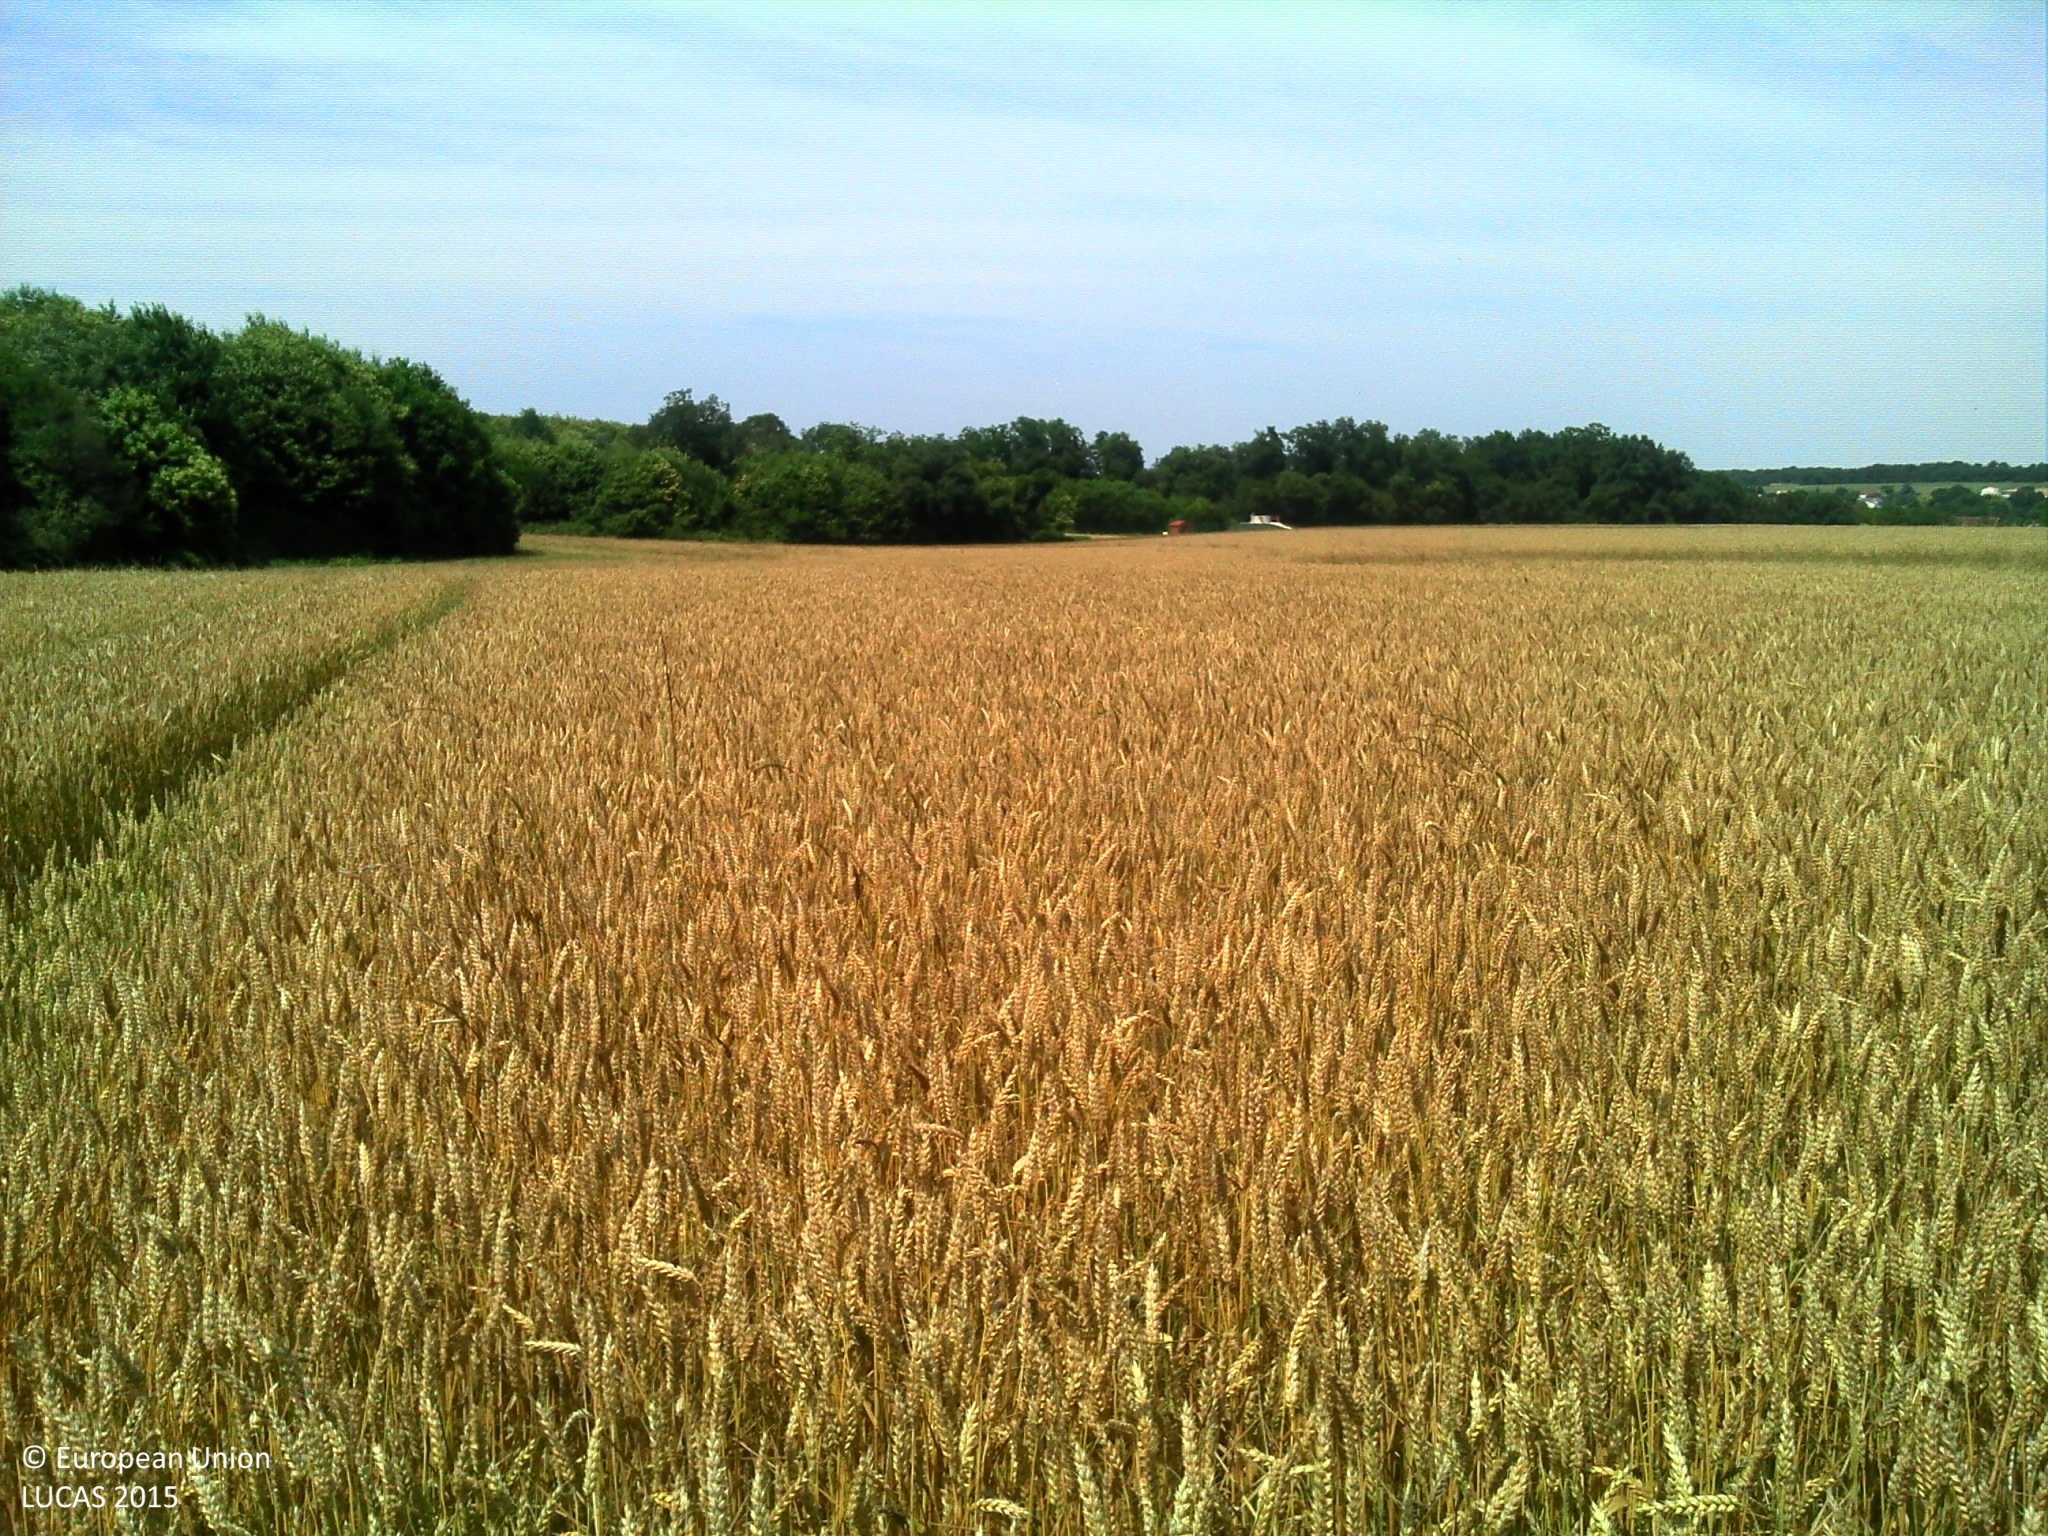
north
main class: Cropland
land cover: Common wheat
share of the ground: > 75 %
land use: Agriculture (excluding fallow land and kitchen gardens)
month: June
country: FR
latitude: 45.7979
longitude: -0.8467
